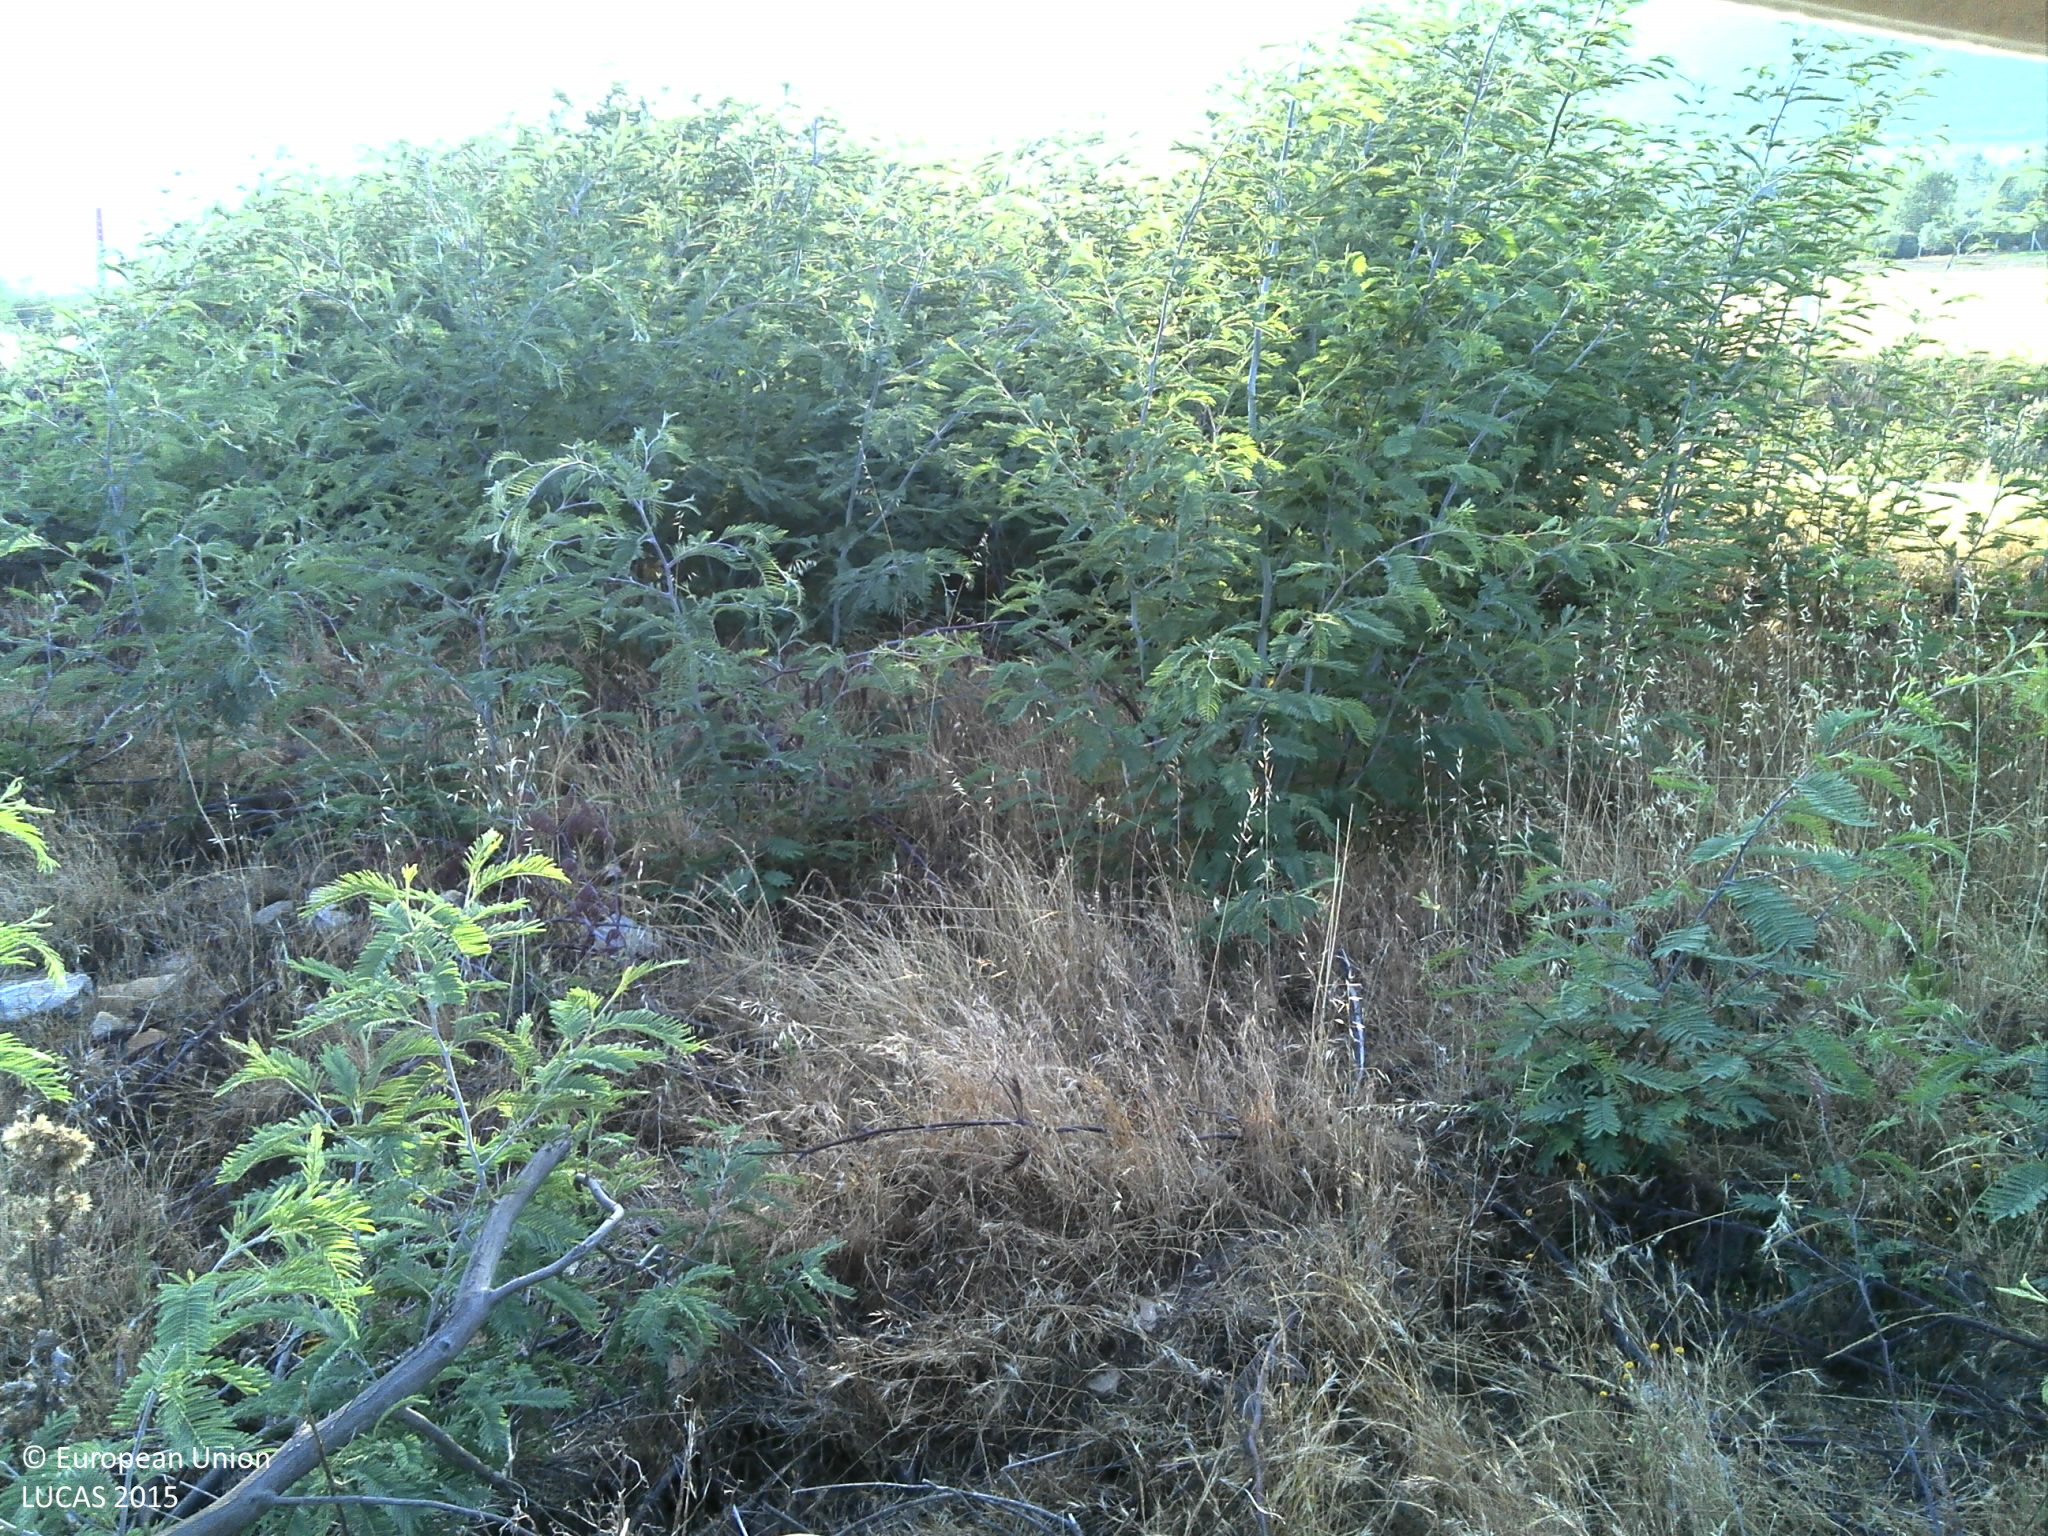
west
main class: Woodland
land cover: Broadleaved woodland
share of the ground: 10 - 25 %
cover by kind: unconsolidated bare surface 65 %, broadleaved forest trees 15 %, herbaceous plants 10 %, consolidated bare surface 10 %
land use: Semi-natural and natural areas not in use
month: June
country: PT
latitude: 41.4514
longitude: -7.2744
